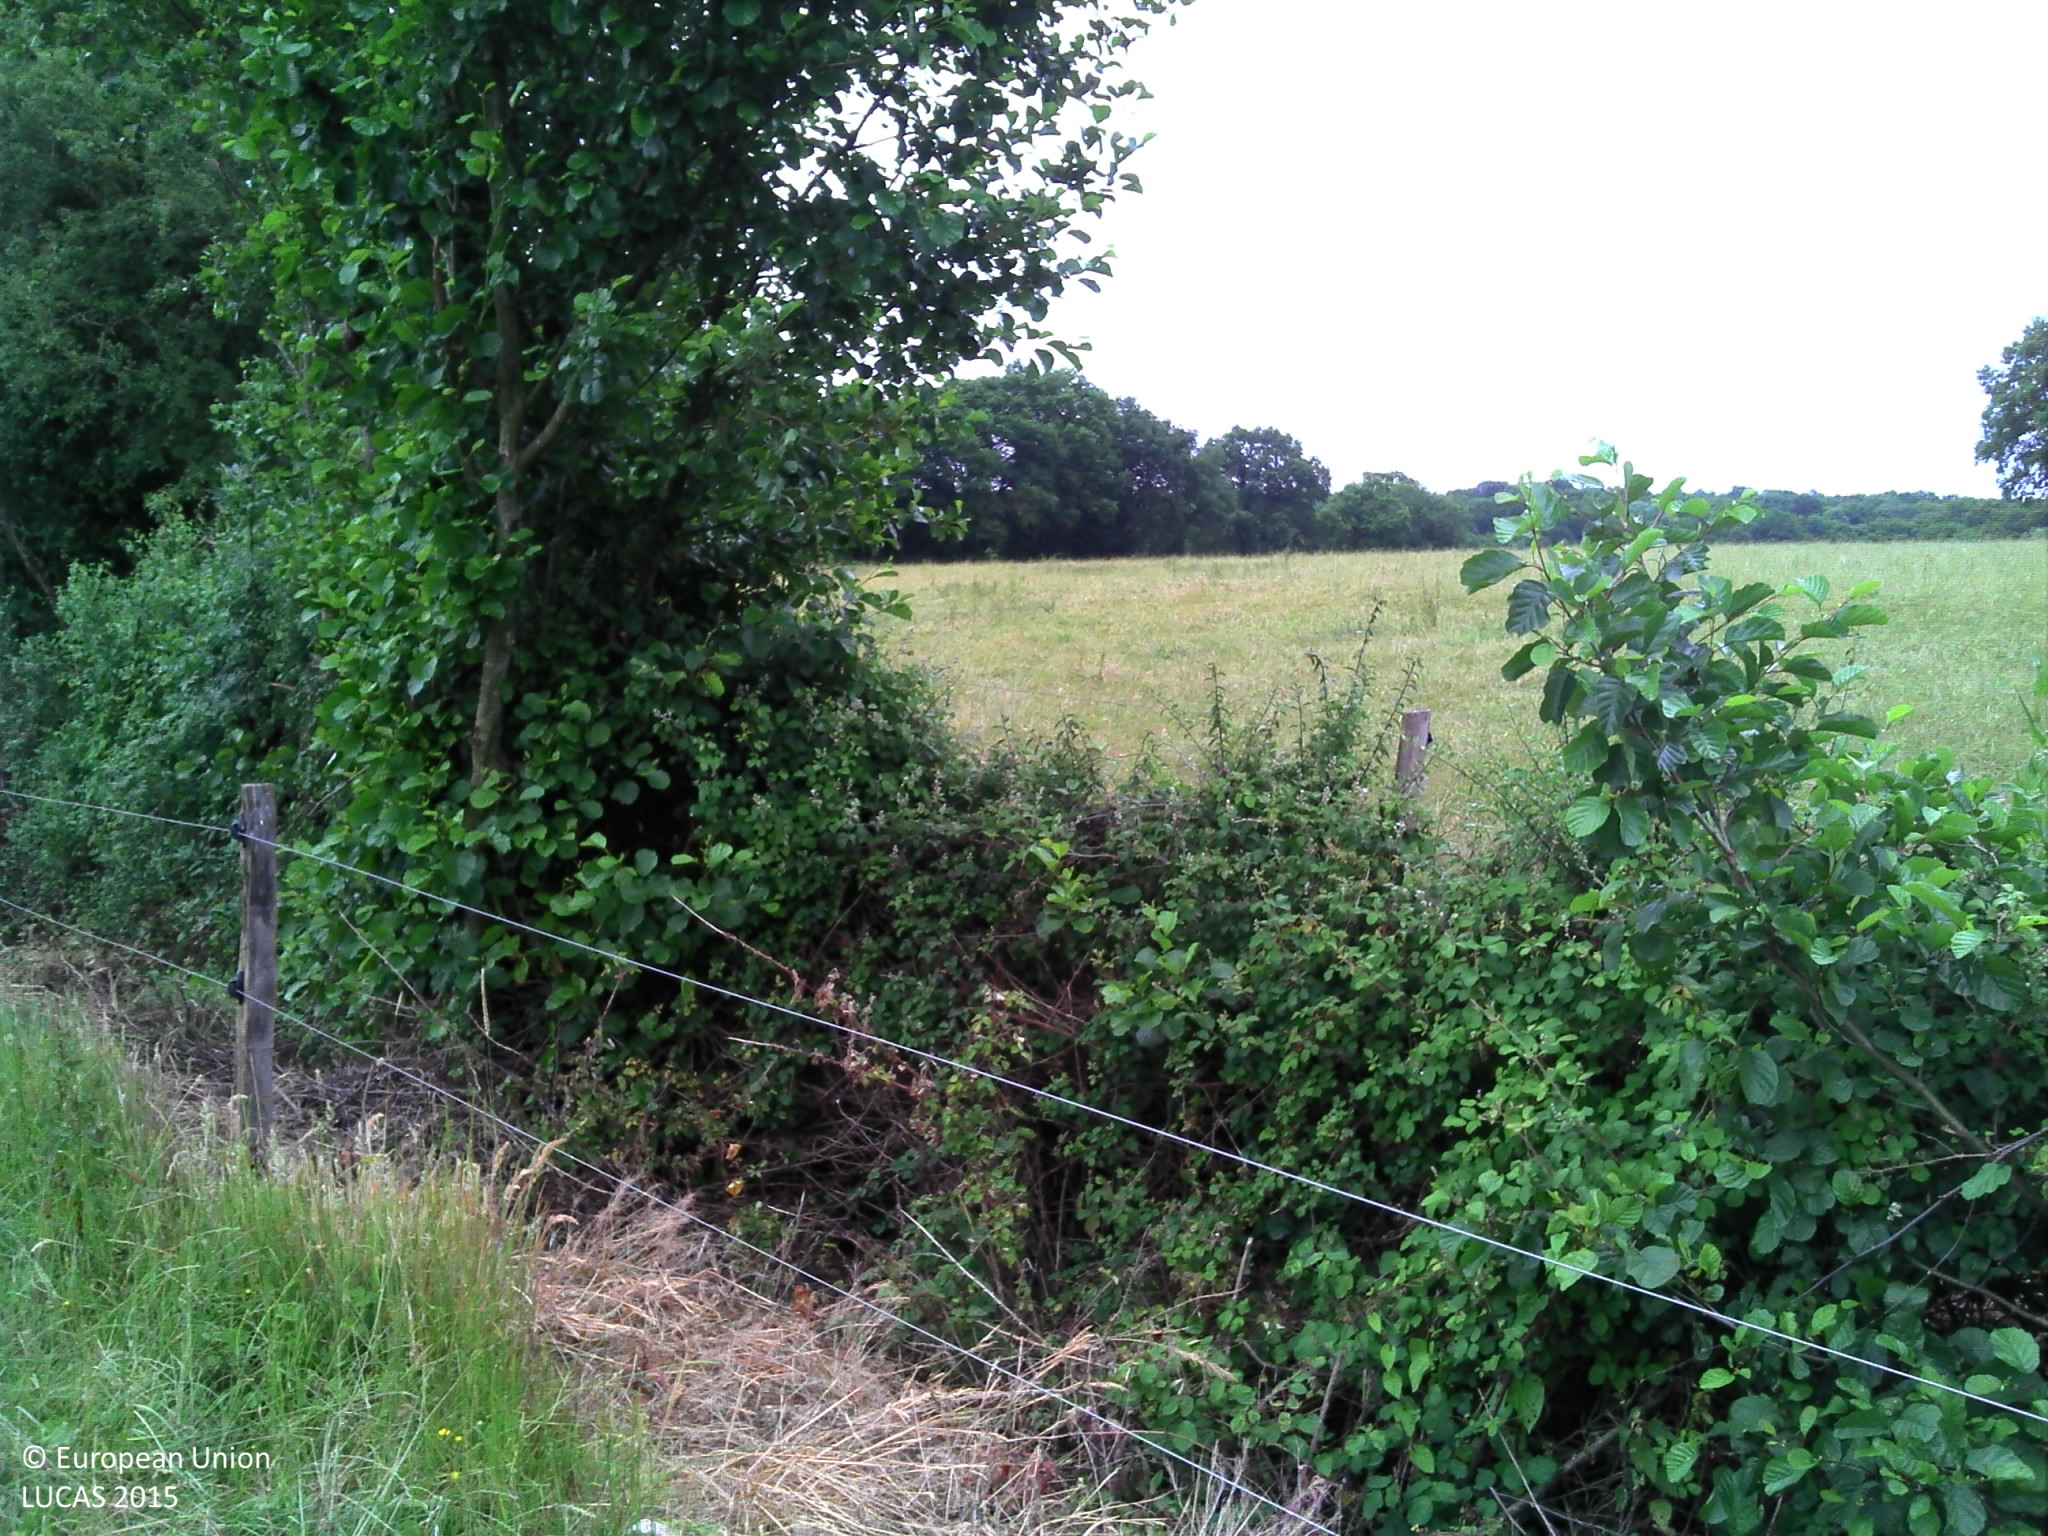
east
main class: Grassland
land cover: Grassland without tree/shrub cover
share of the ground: > 75 %
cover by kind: herbaceous plants 100 %
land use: Agriculture (excluding fallow land and kitchen gardens)
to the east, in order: Grassland without tree/shrub cover; Fences; Abandoned hedges; Ditches and canals; Grassland without tree/shrub cover; Barley
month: June
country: FR
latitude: 46.7689
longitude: 2.6750
